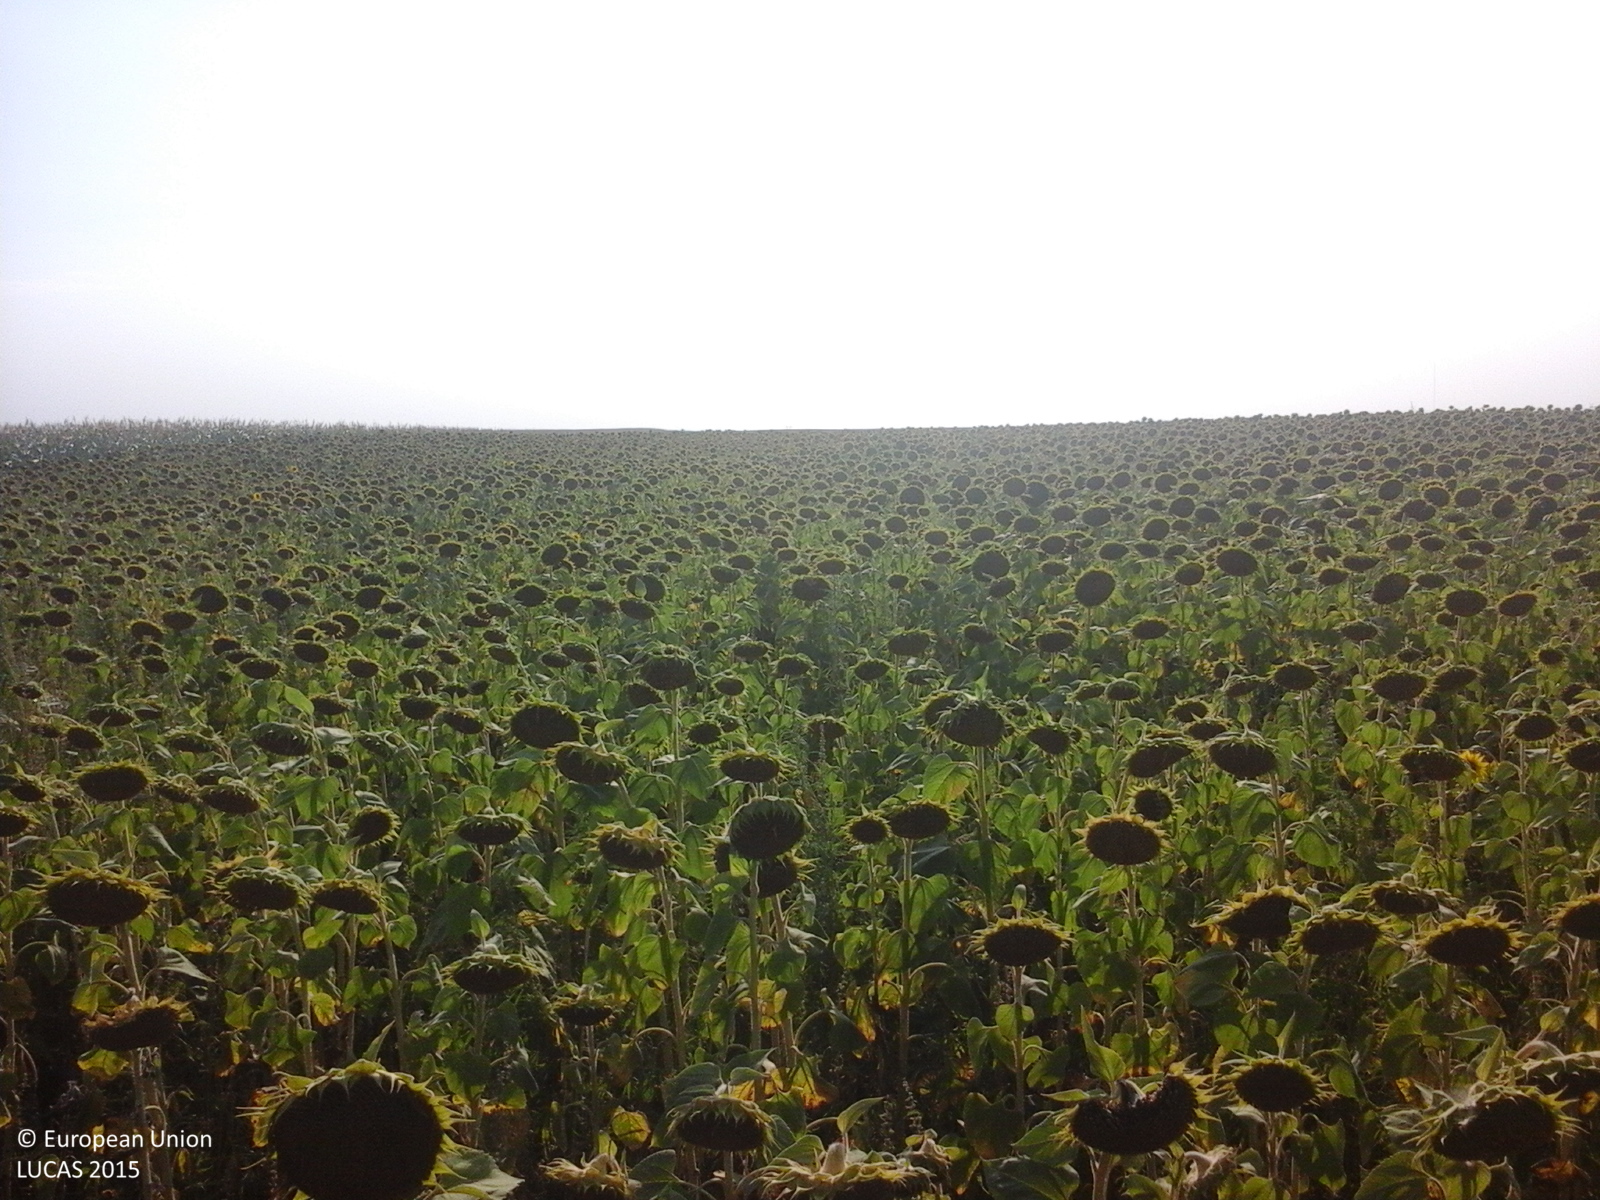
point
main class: Cropland
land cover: Sunflower
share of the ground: > 75 %
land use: Agriculture (excluding fallow land and kitchen gardens)
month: August
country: RO
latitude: 44.0755
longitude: 28.0735
